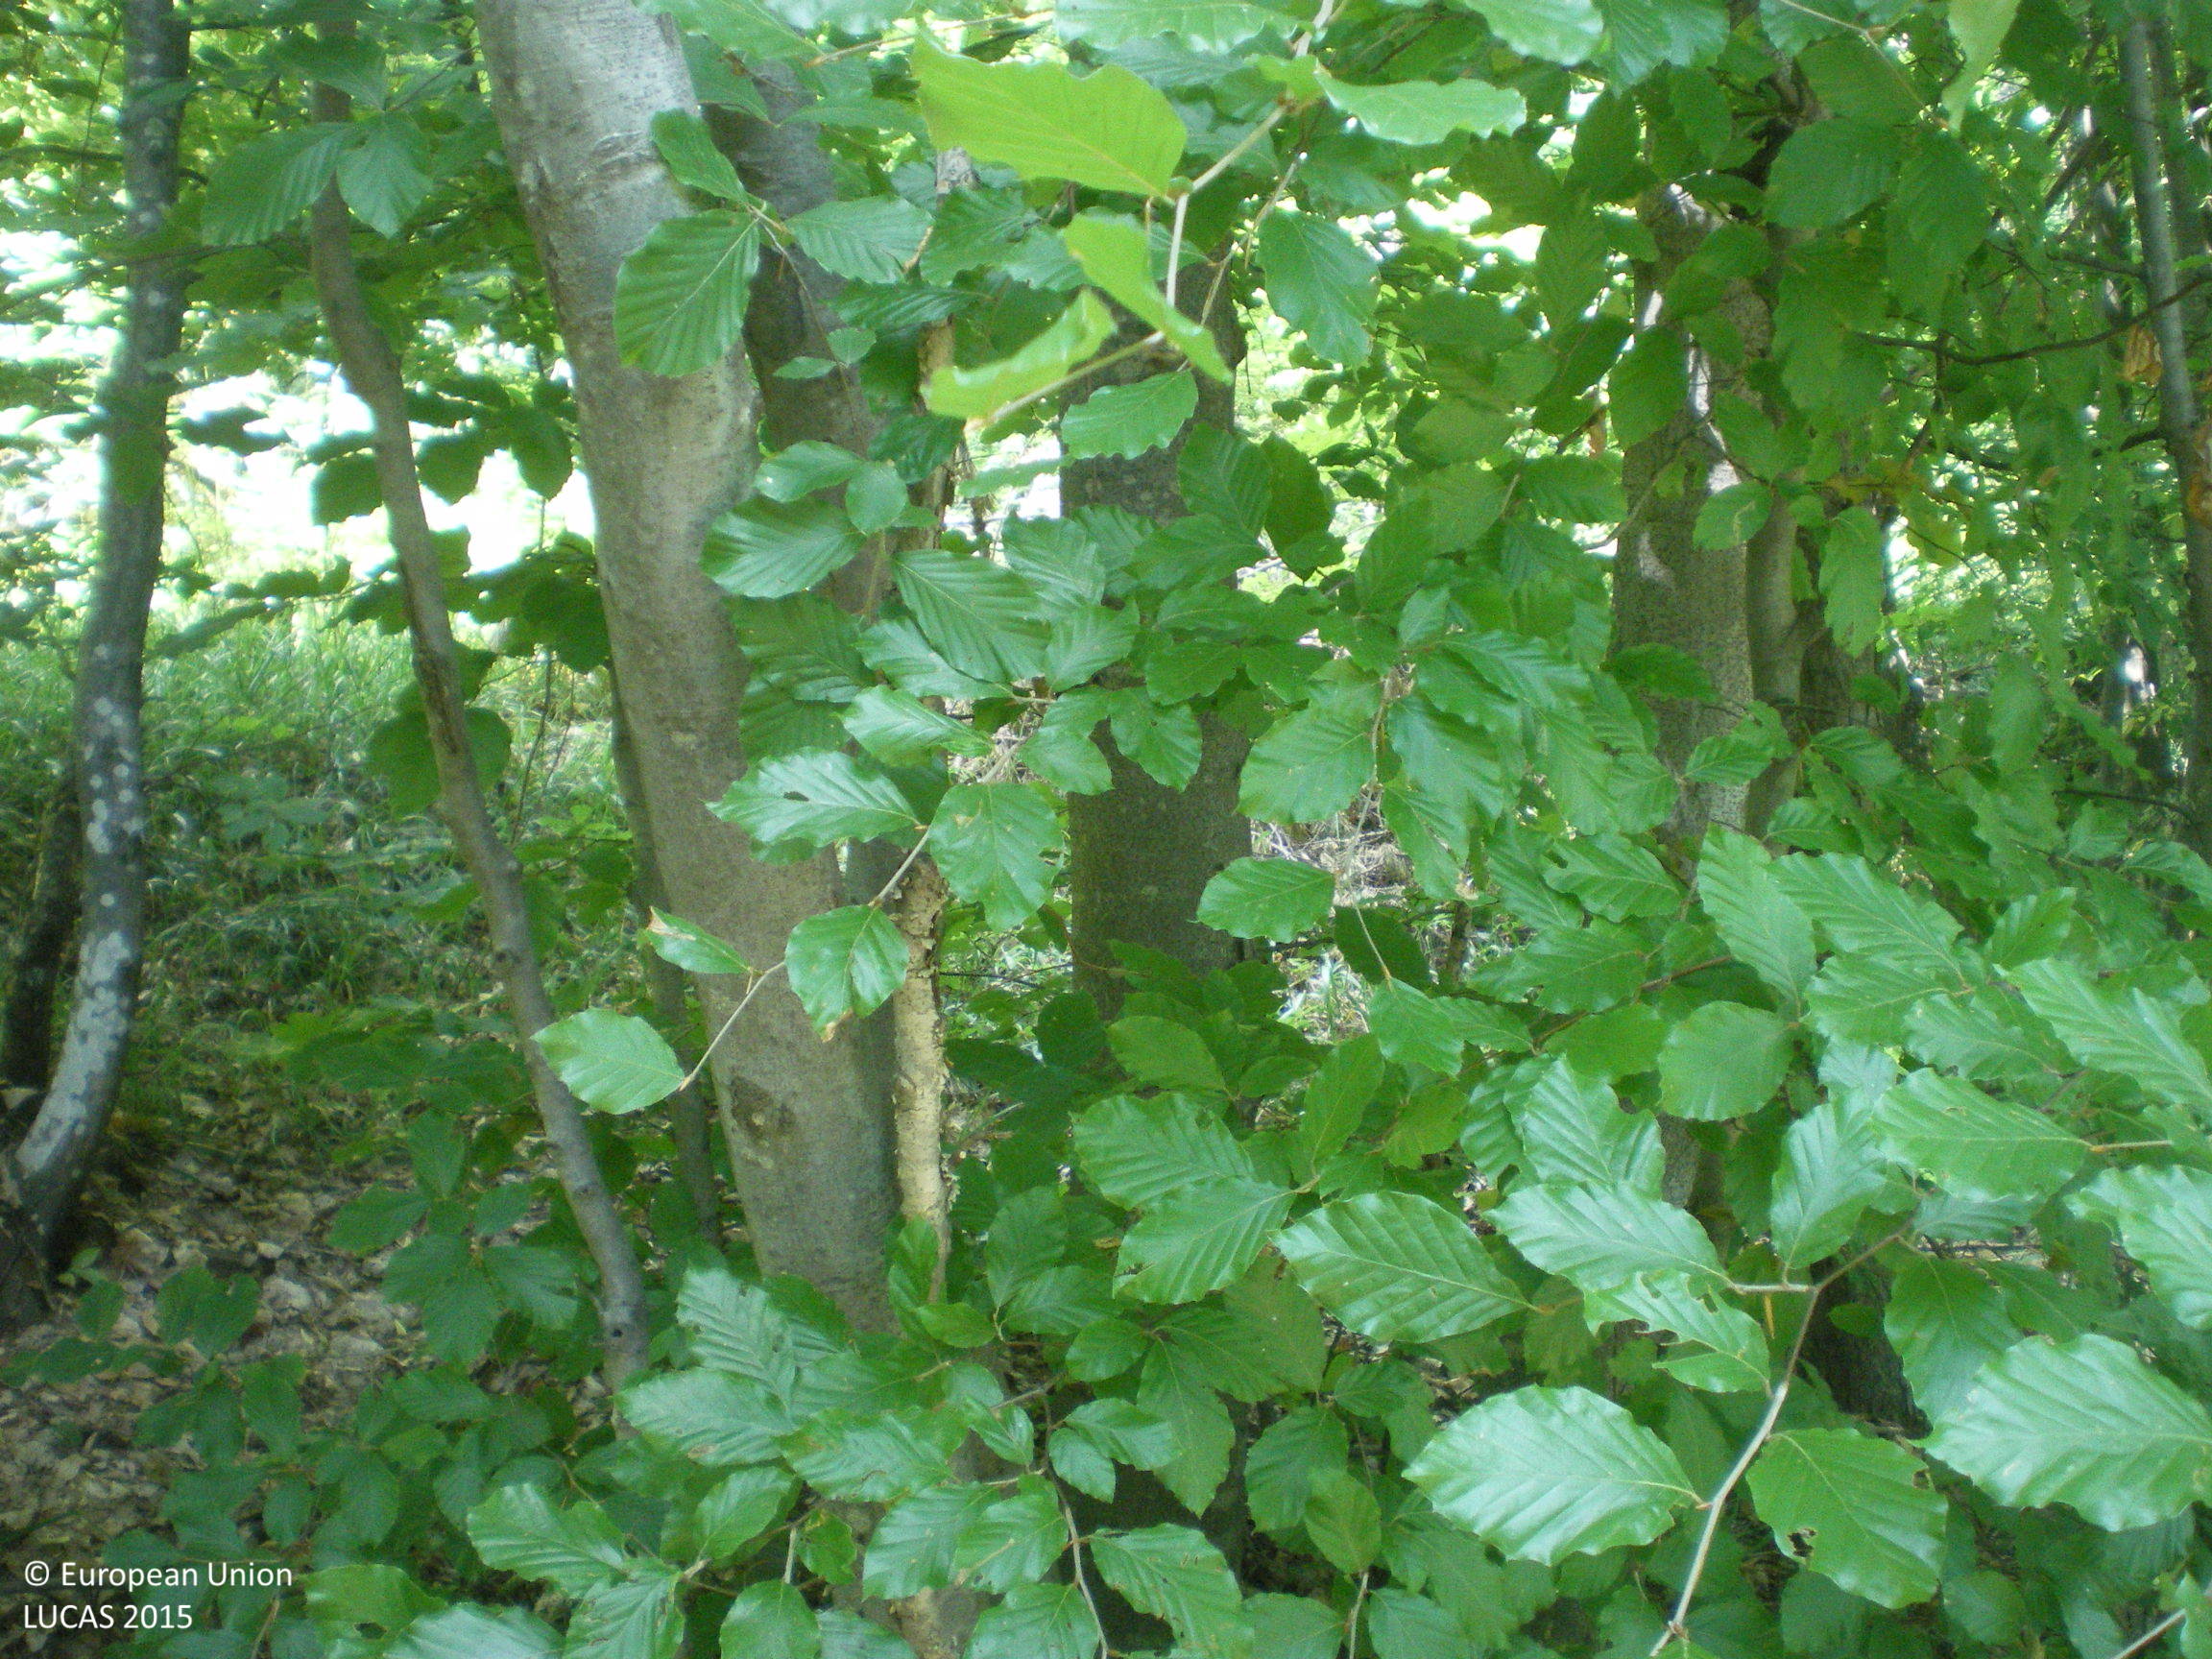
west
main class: Woodland
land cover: Broadleaved woodland
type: mesophytic deciduous forest
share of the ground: > 75 %
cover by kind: broadleaved forest trees 90 %, unconsolidated bare surface 10 %
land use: Forestry
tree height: > 5 m
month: July
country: BG
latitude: 42.4916
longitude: 25.1872
